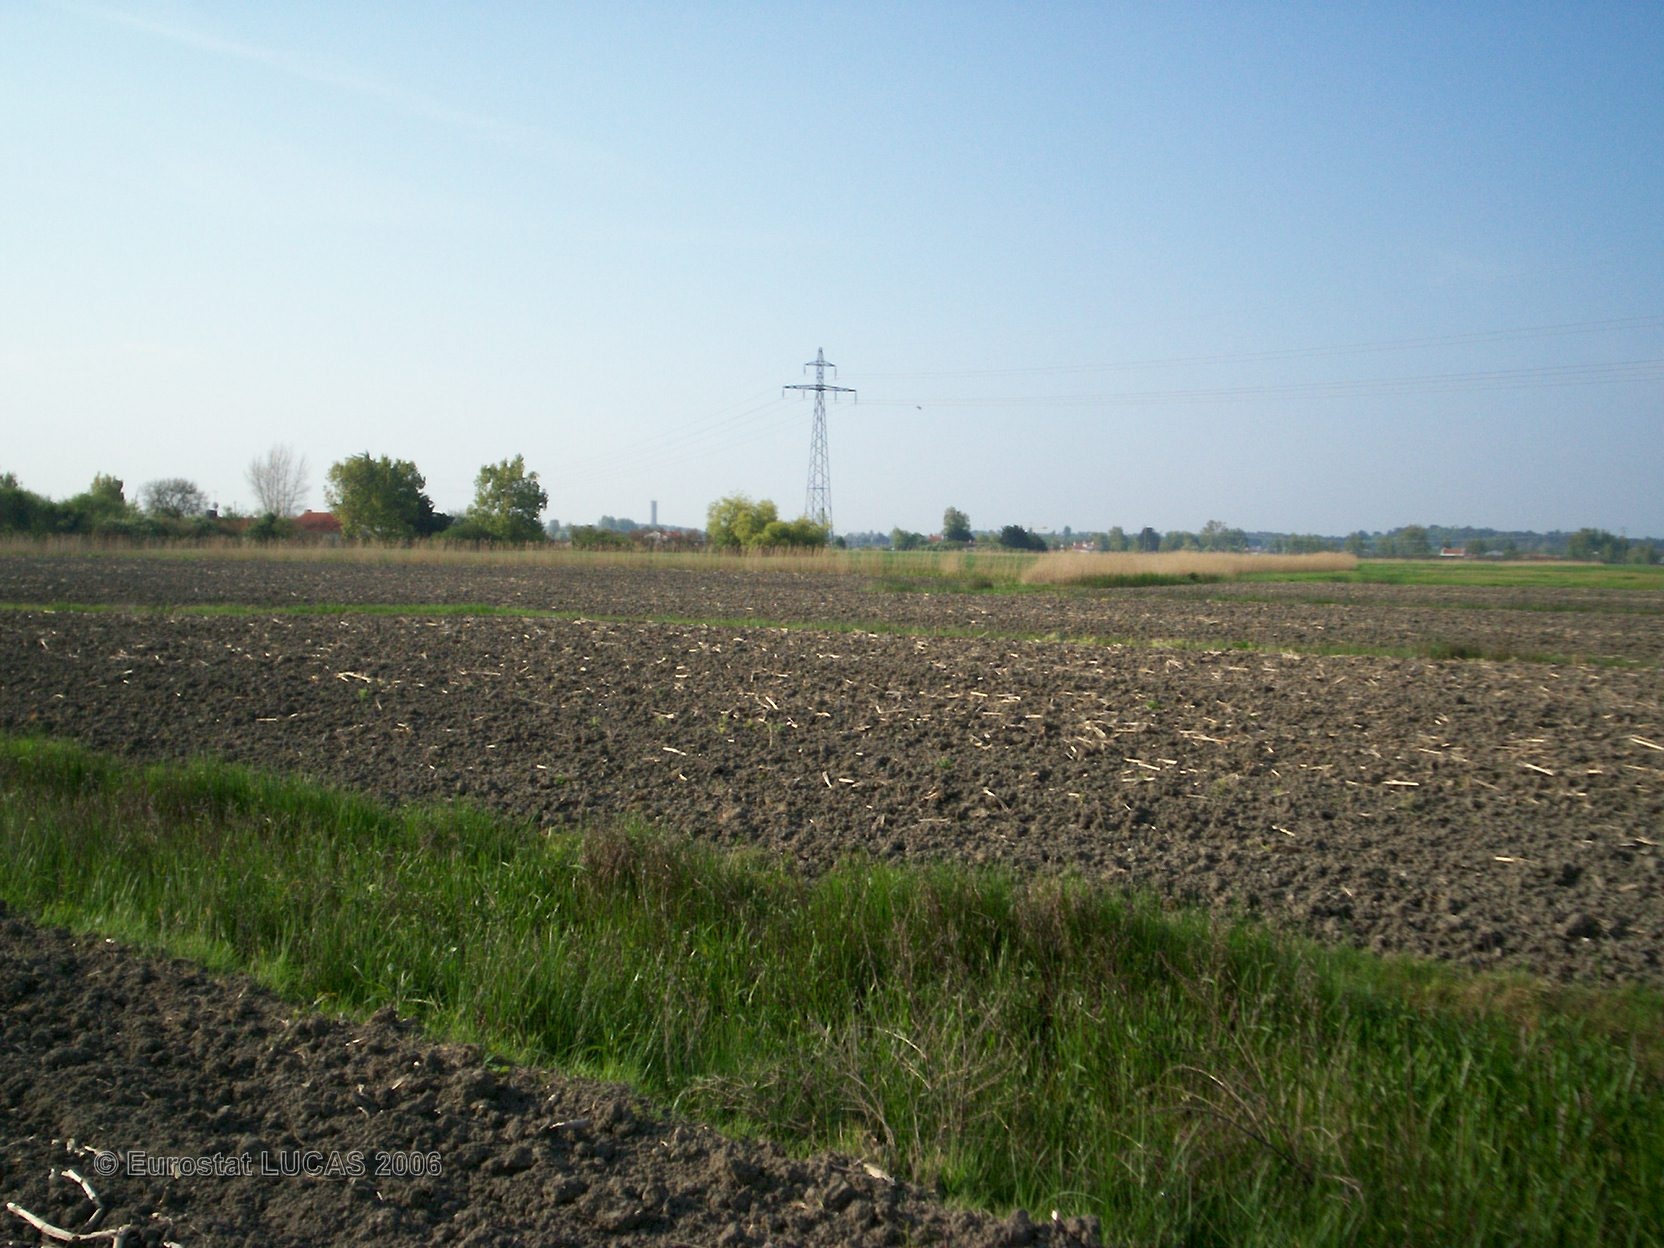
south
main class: Cropland
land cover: Other cereals
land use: Agriculture (excluding fallow land and kitchen gardens)
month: May
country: FR
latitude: 46.8122
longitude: -2.0645
